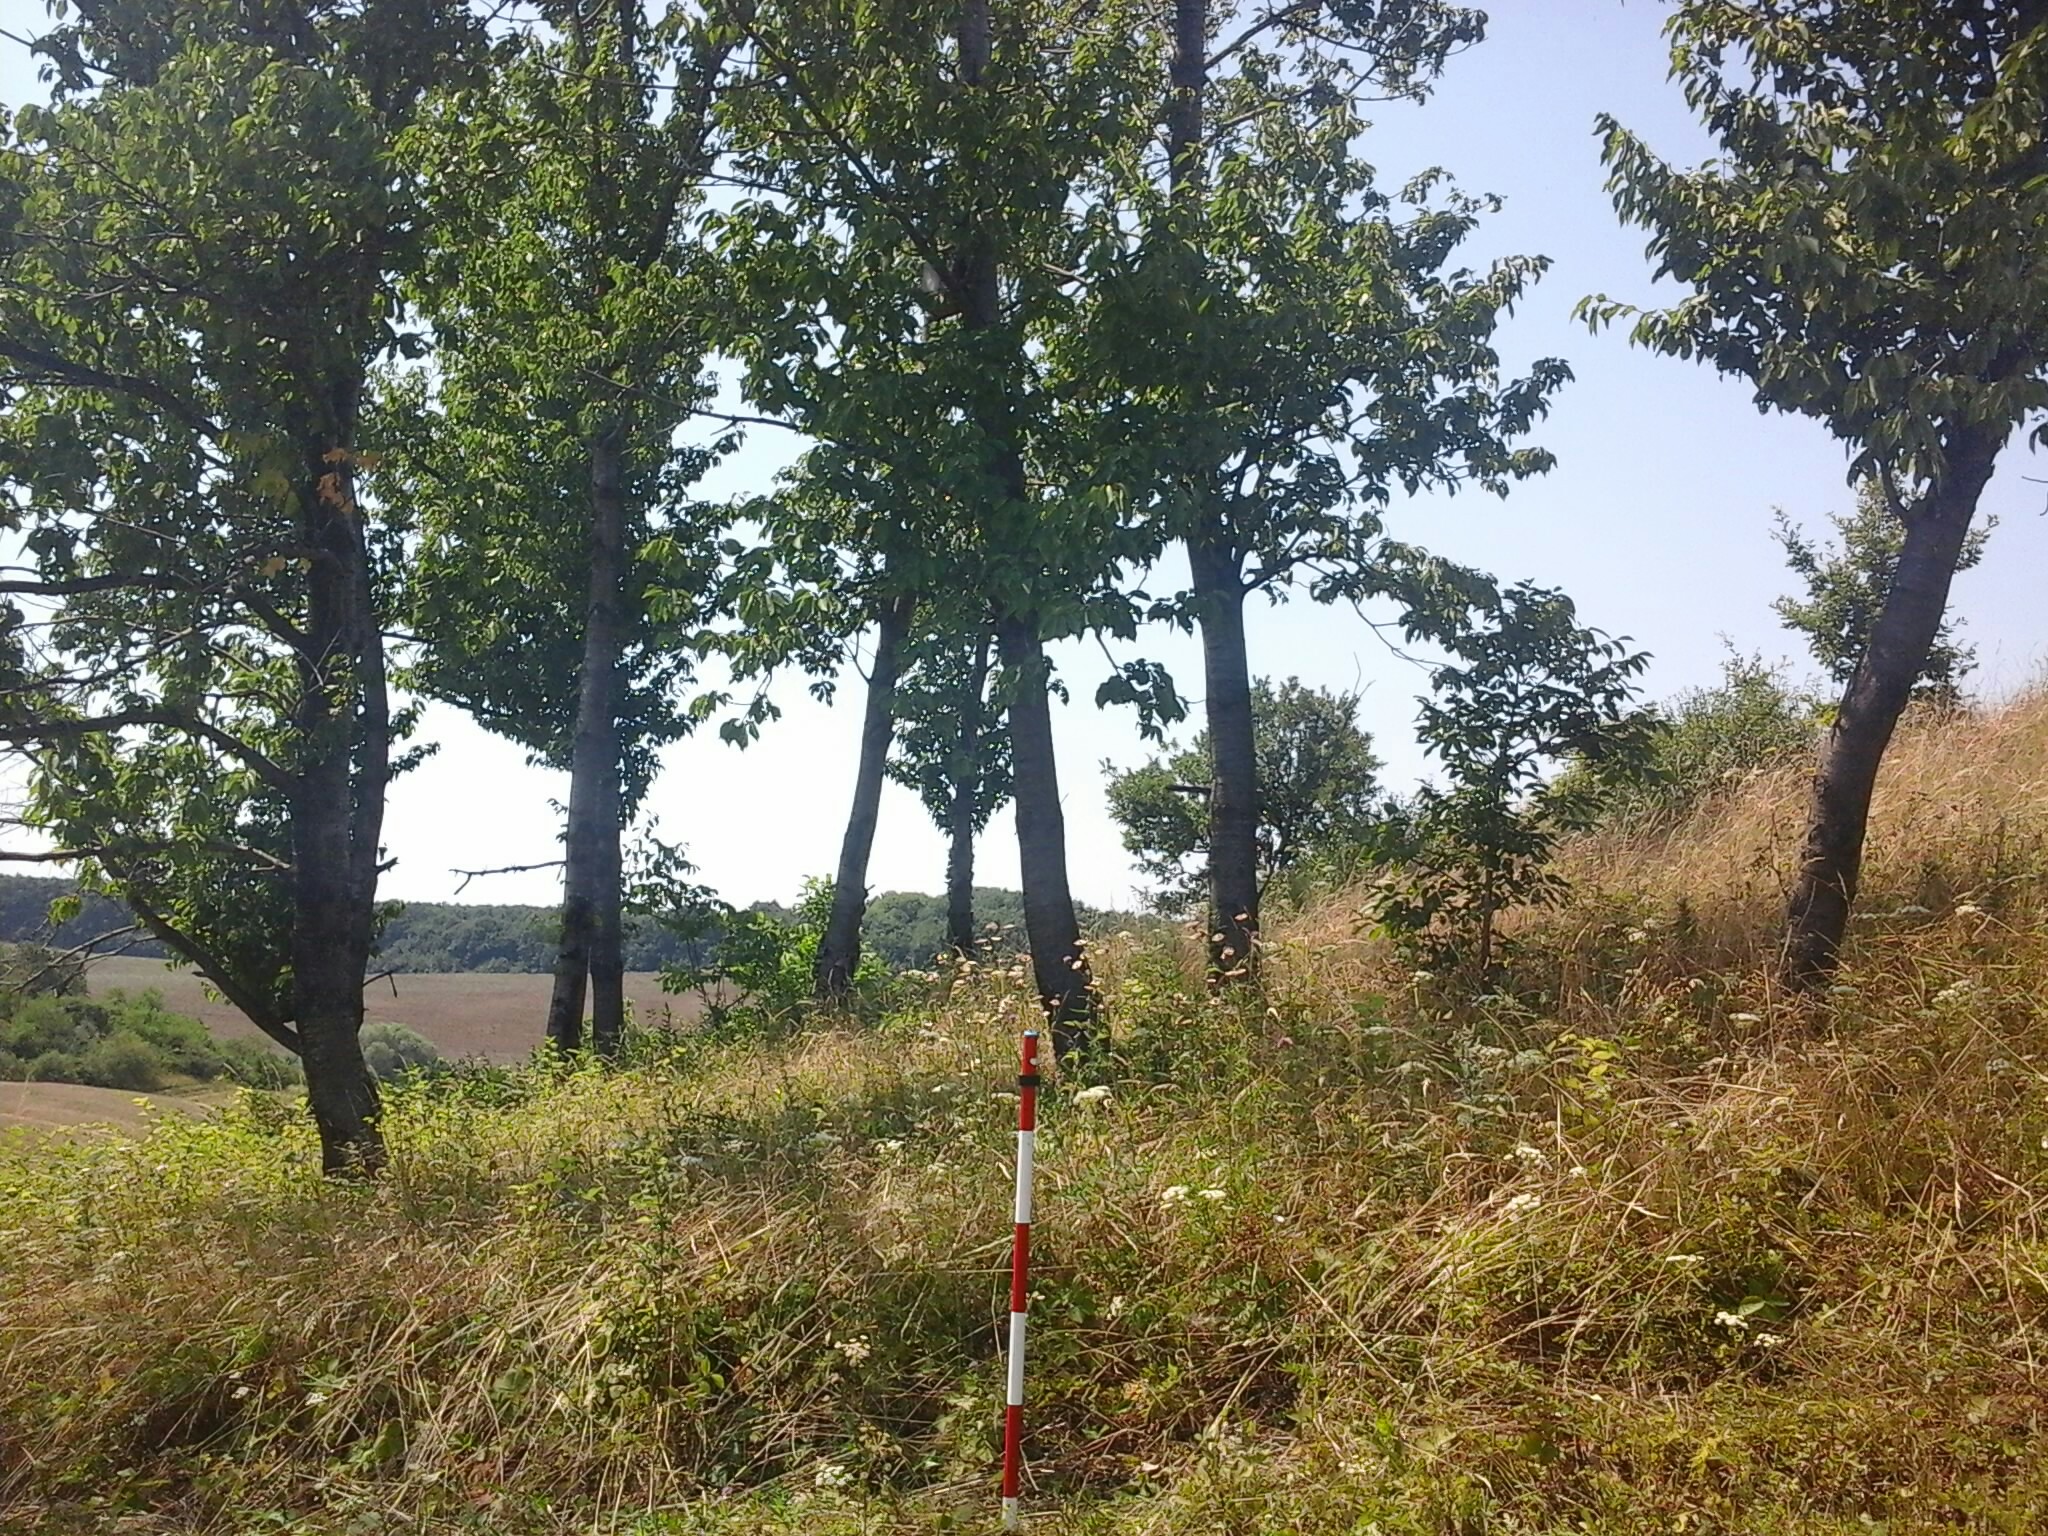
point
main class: Grassland
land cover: Grassland with sparse tree/shrub cover
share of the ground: > 75 %
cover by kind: herbaceous plants 85 %, shrubs 10 %, broadleaved forest trees 5 %
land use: Fallow land
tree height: > 5 m
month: August
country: HU
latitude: 47.4080
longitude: 18.0015
